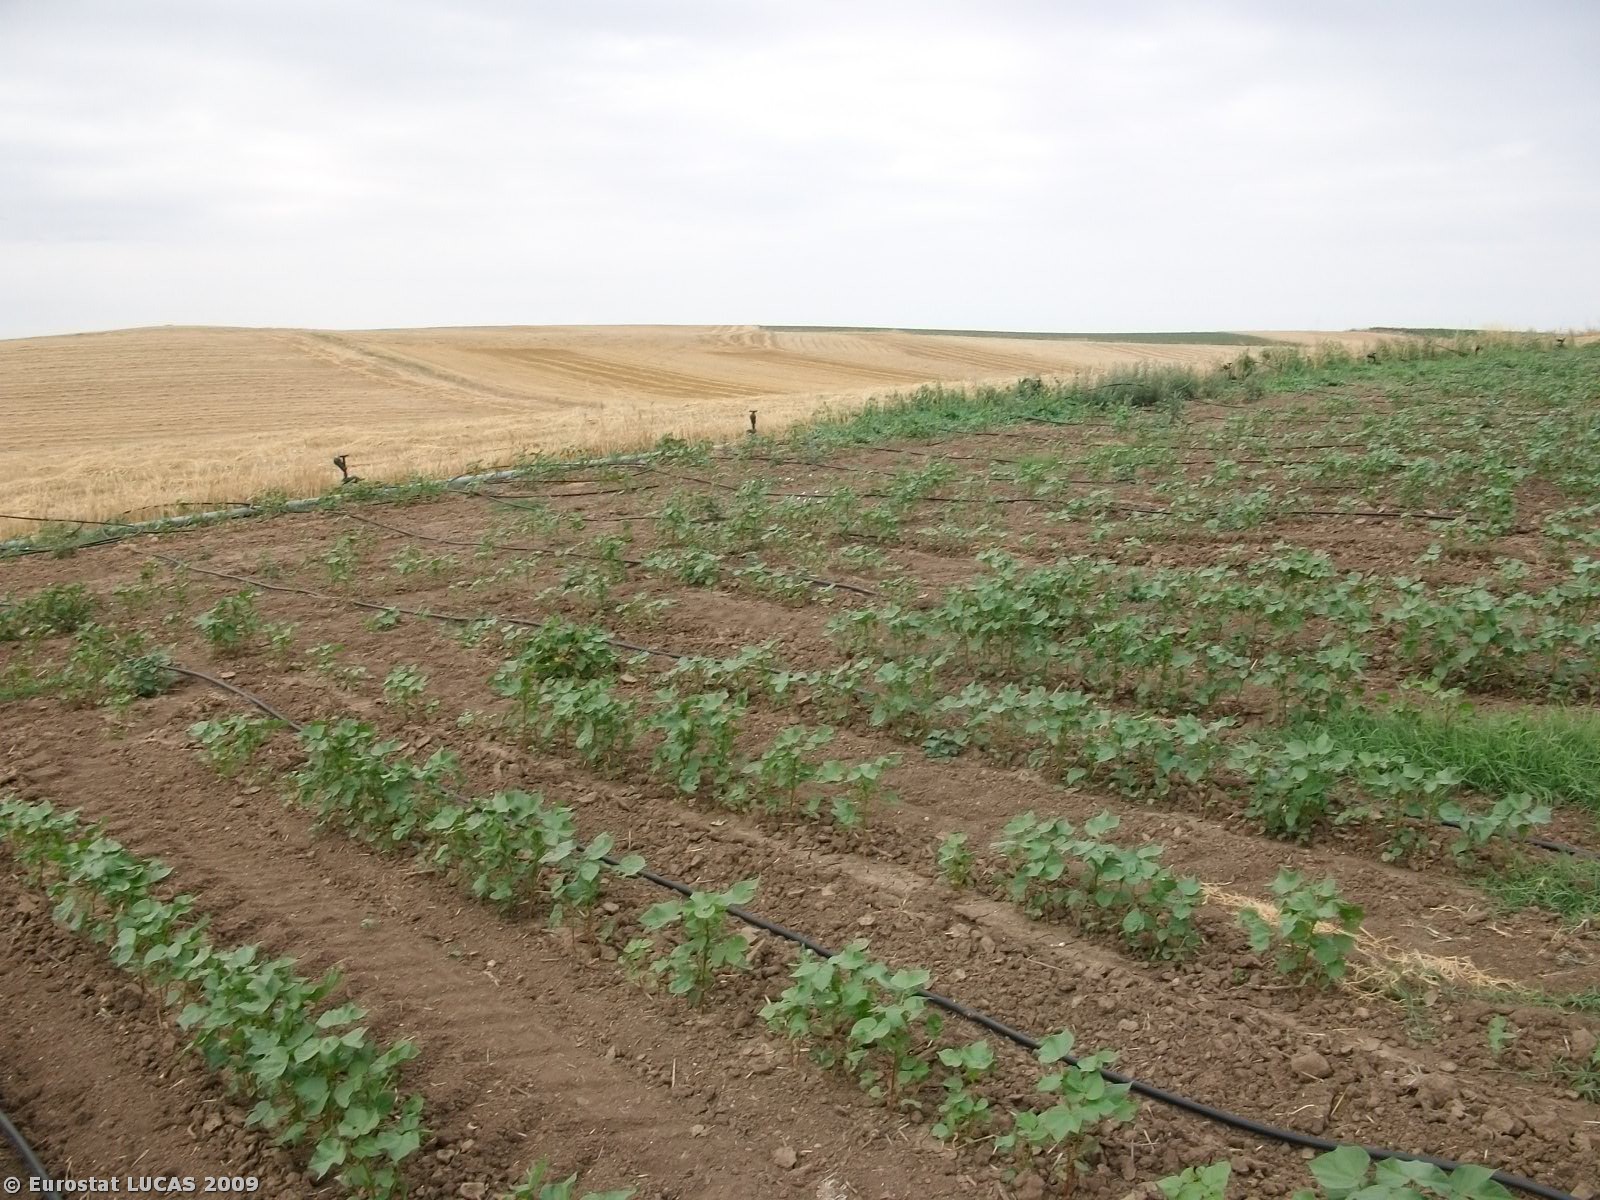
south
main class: Cropland
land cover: Cotton
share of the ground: 10 - 25 %
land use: Agriculture (excluding fallow land and kitchen gardens)
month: April
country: GR
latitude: 39.5706
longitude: 22.3861
